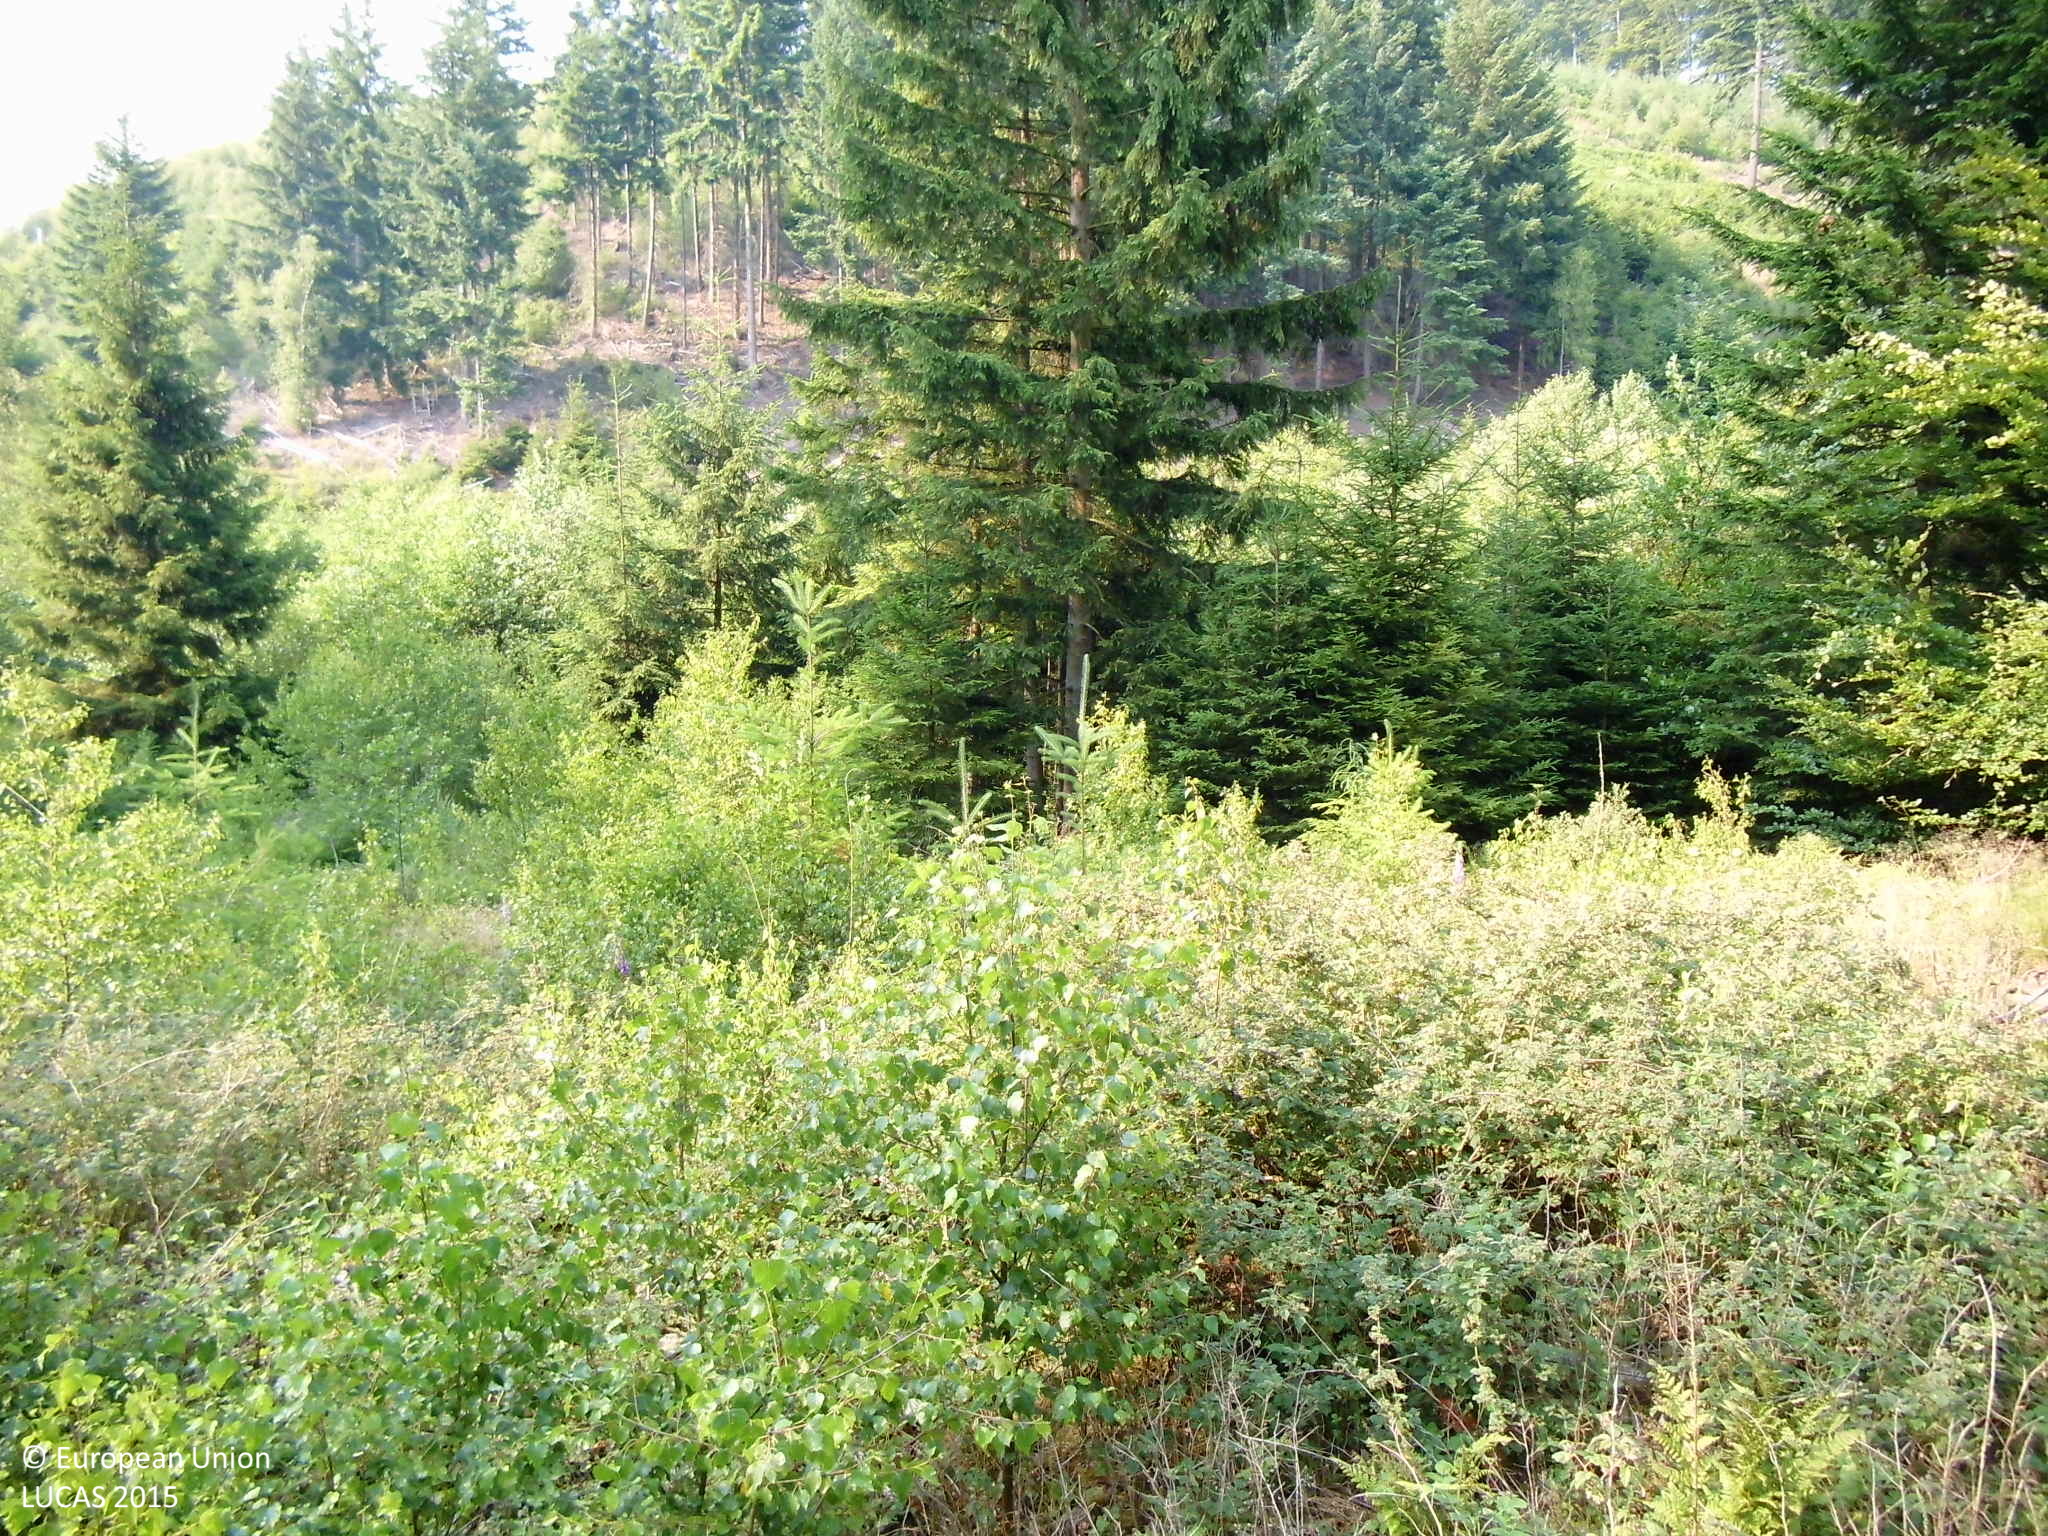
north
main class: Shrubland
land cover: Shrubland with sparse tree cover
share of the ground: 50 - 75 %
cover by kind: shrubs 50 %, herbaceous plants 35 %, broadleaved forest trees 5 %, lichens and mosses 5 %, unconsolidated bare surface 5 %
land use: Forestry
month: July
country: DE
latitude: 51.3538
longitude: 8.0044
